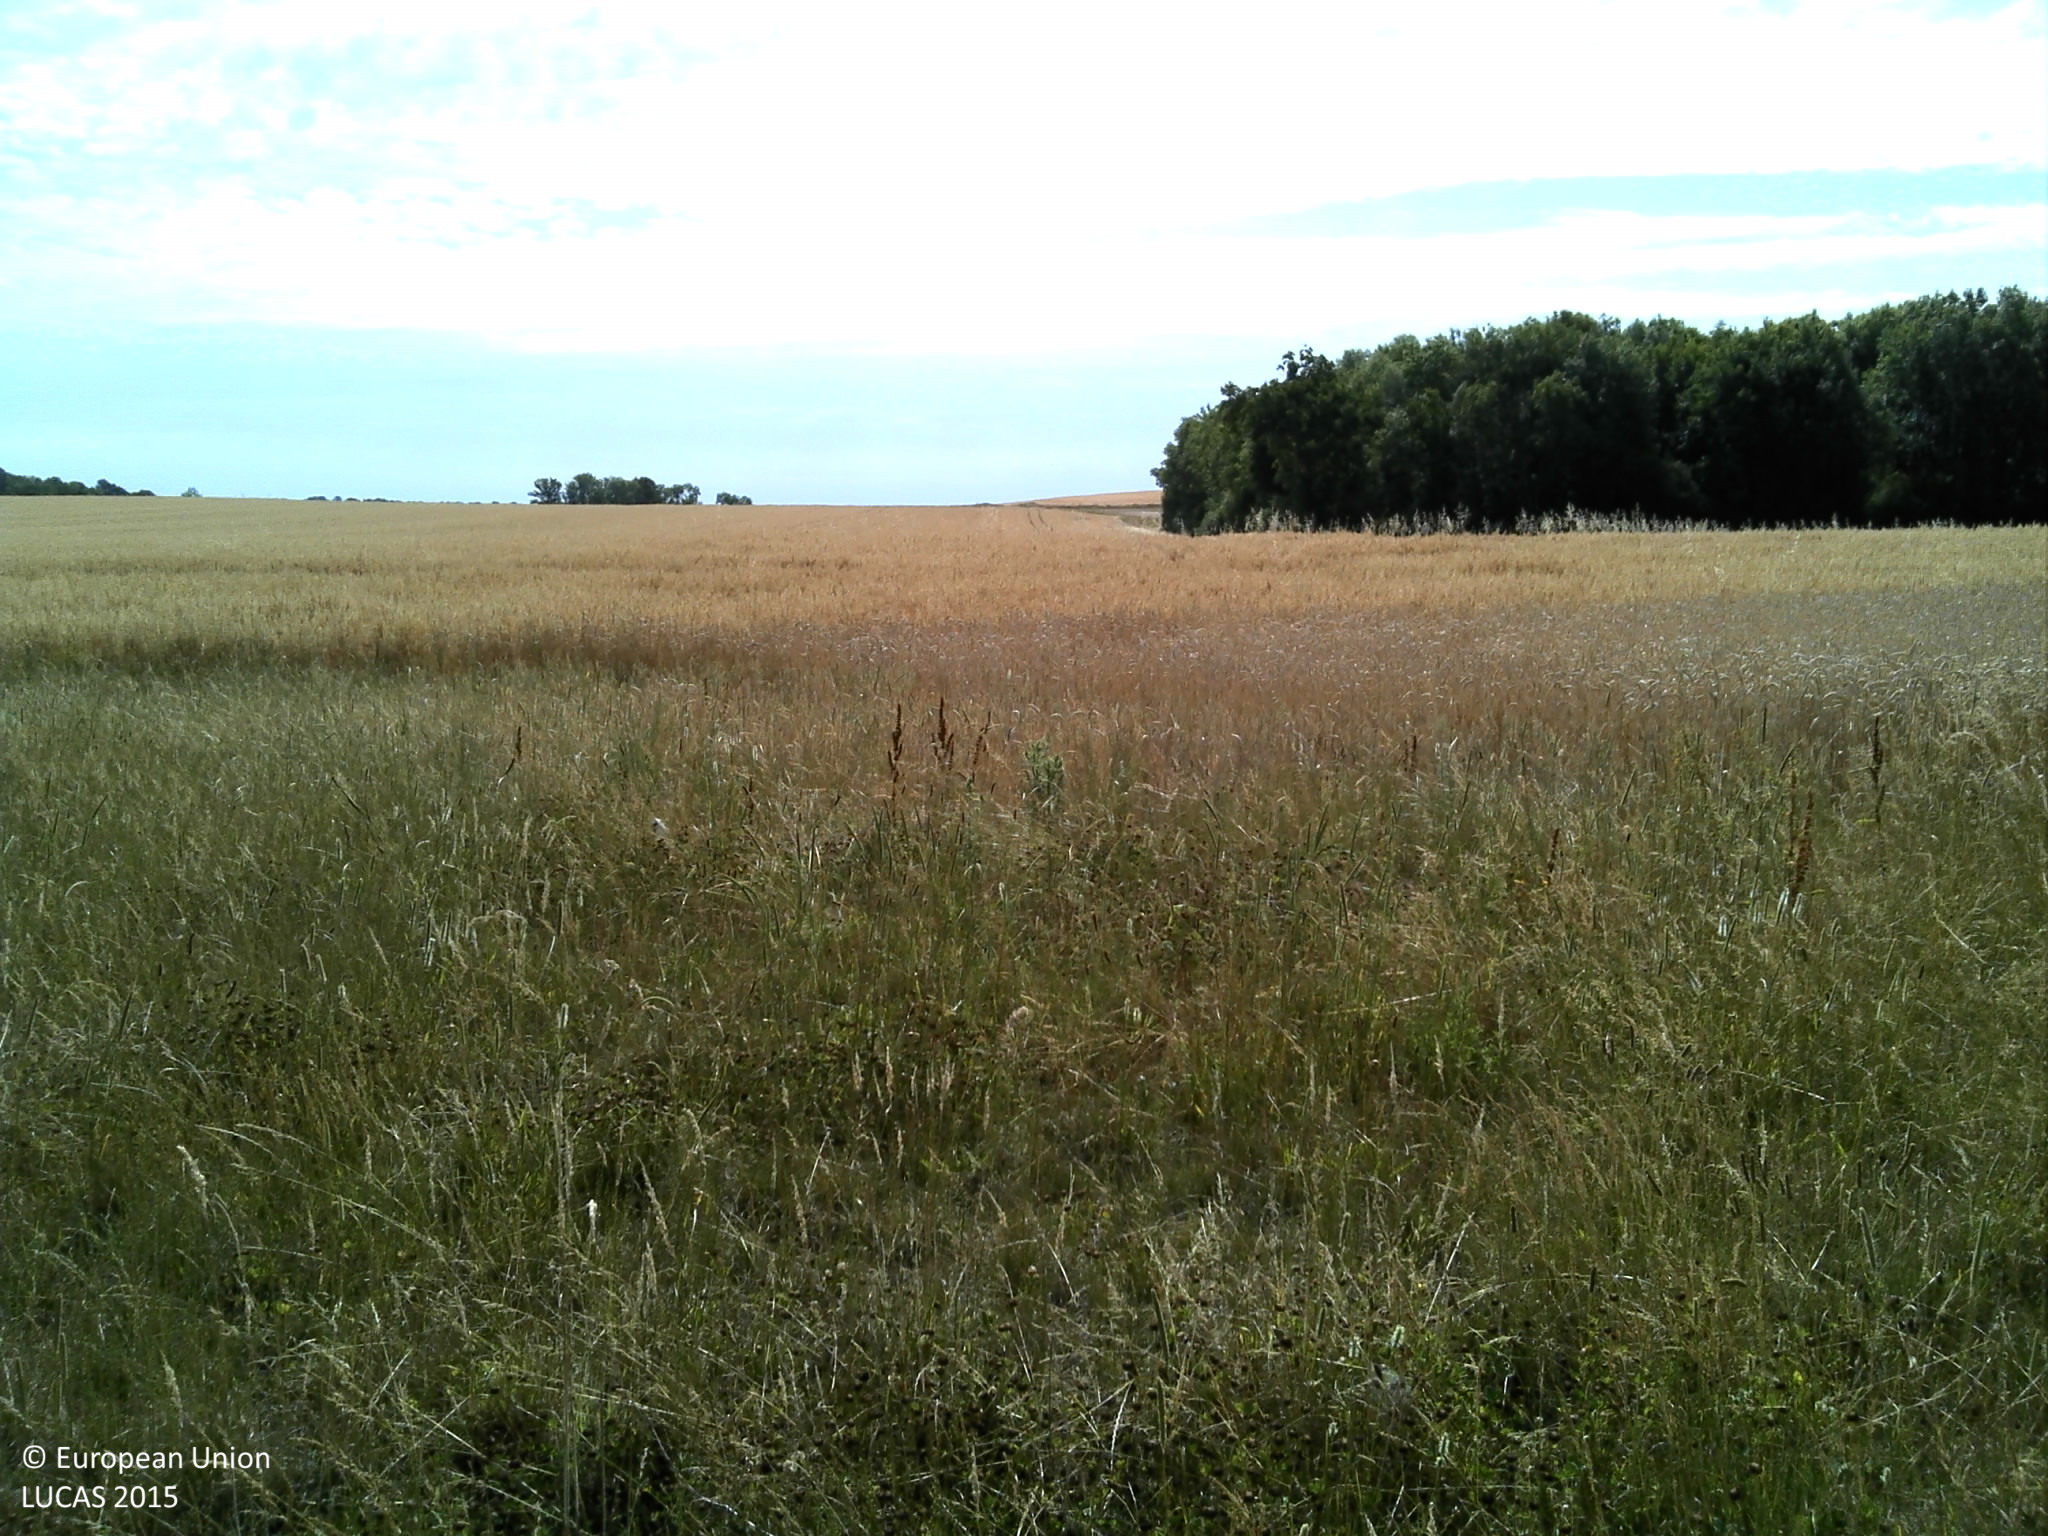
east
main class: Grassland
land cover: Grassland without tree/shrub cover
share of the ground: > 75 %
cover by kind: herbaceous plants 100 %
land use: Agriculture (excluding fallow land and kitchen gardens)
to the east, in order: Grassland without tree/shrub cover; Common wheat; Oats
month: July
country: FR
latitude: 48.9146
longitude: 4.8533
